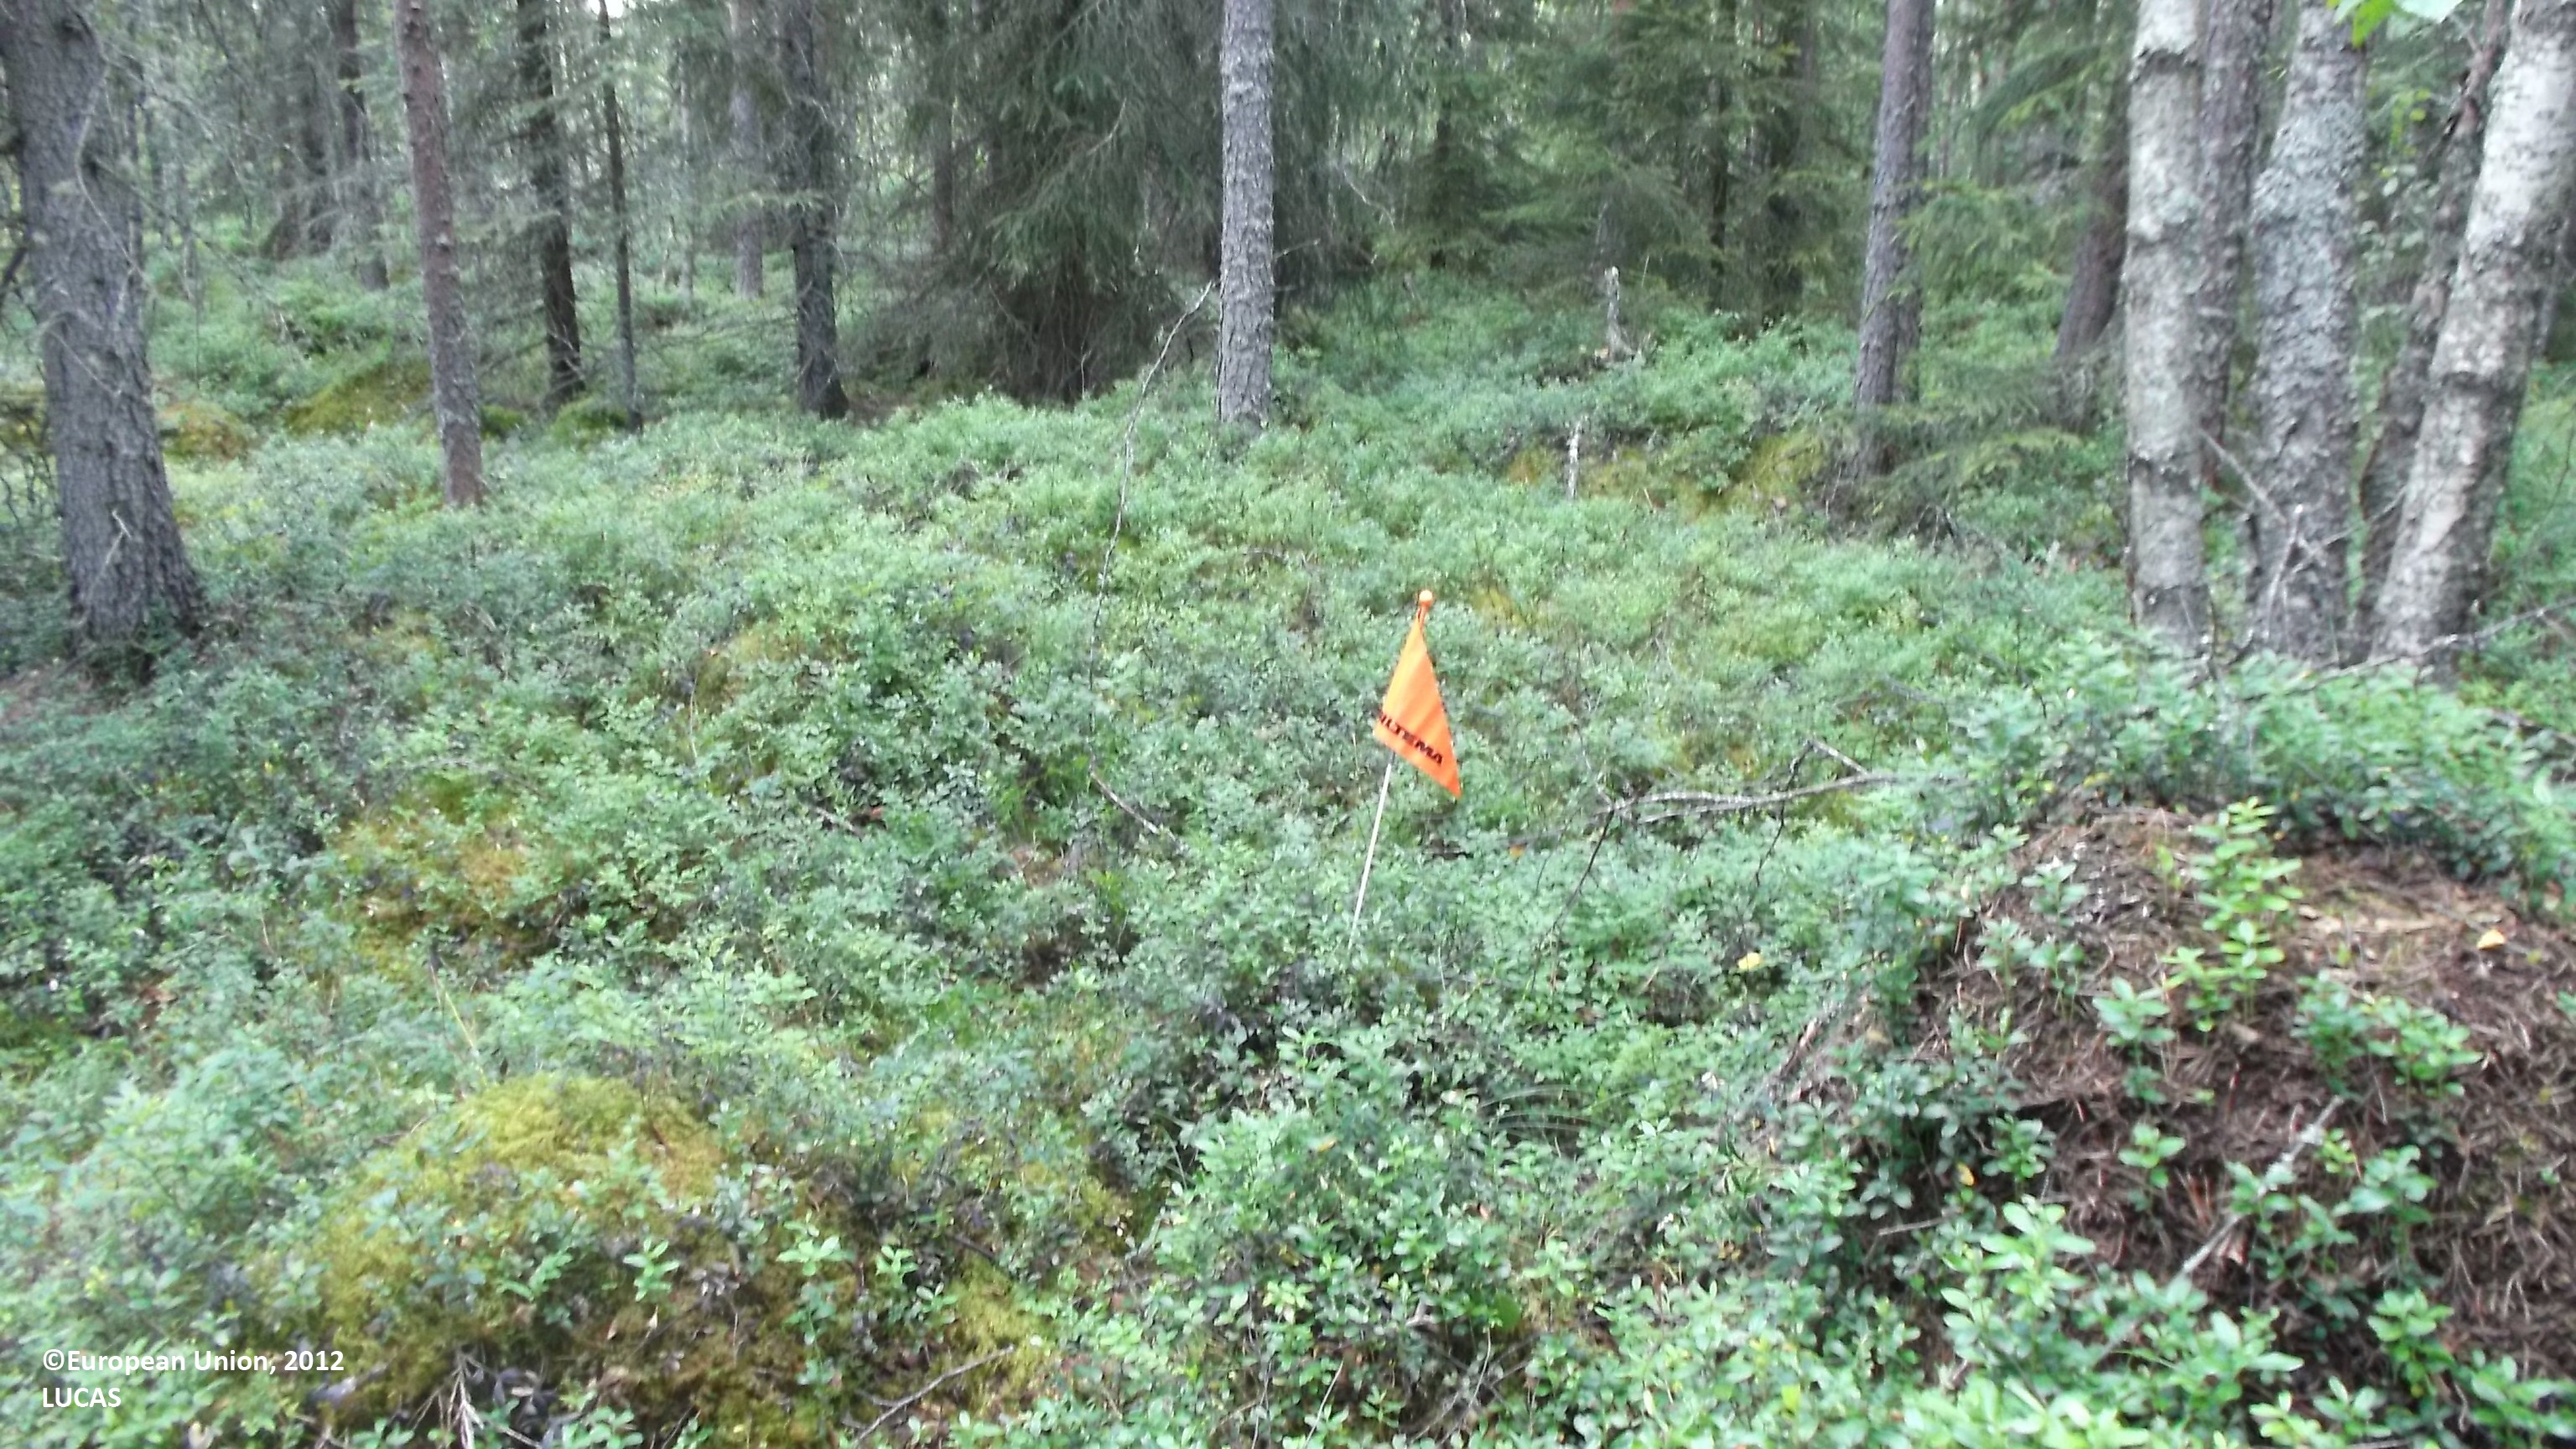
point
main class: Woodland
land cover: Other mixed woodland
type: boreal forest
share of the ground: 50 - 75 %
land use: Forestry
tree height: > 5 m
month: August
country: FI
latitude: 63.9499
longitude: 23.6733
